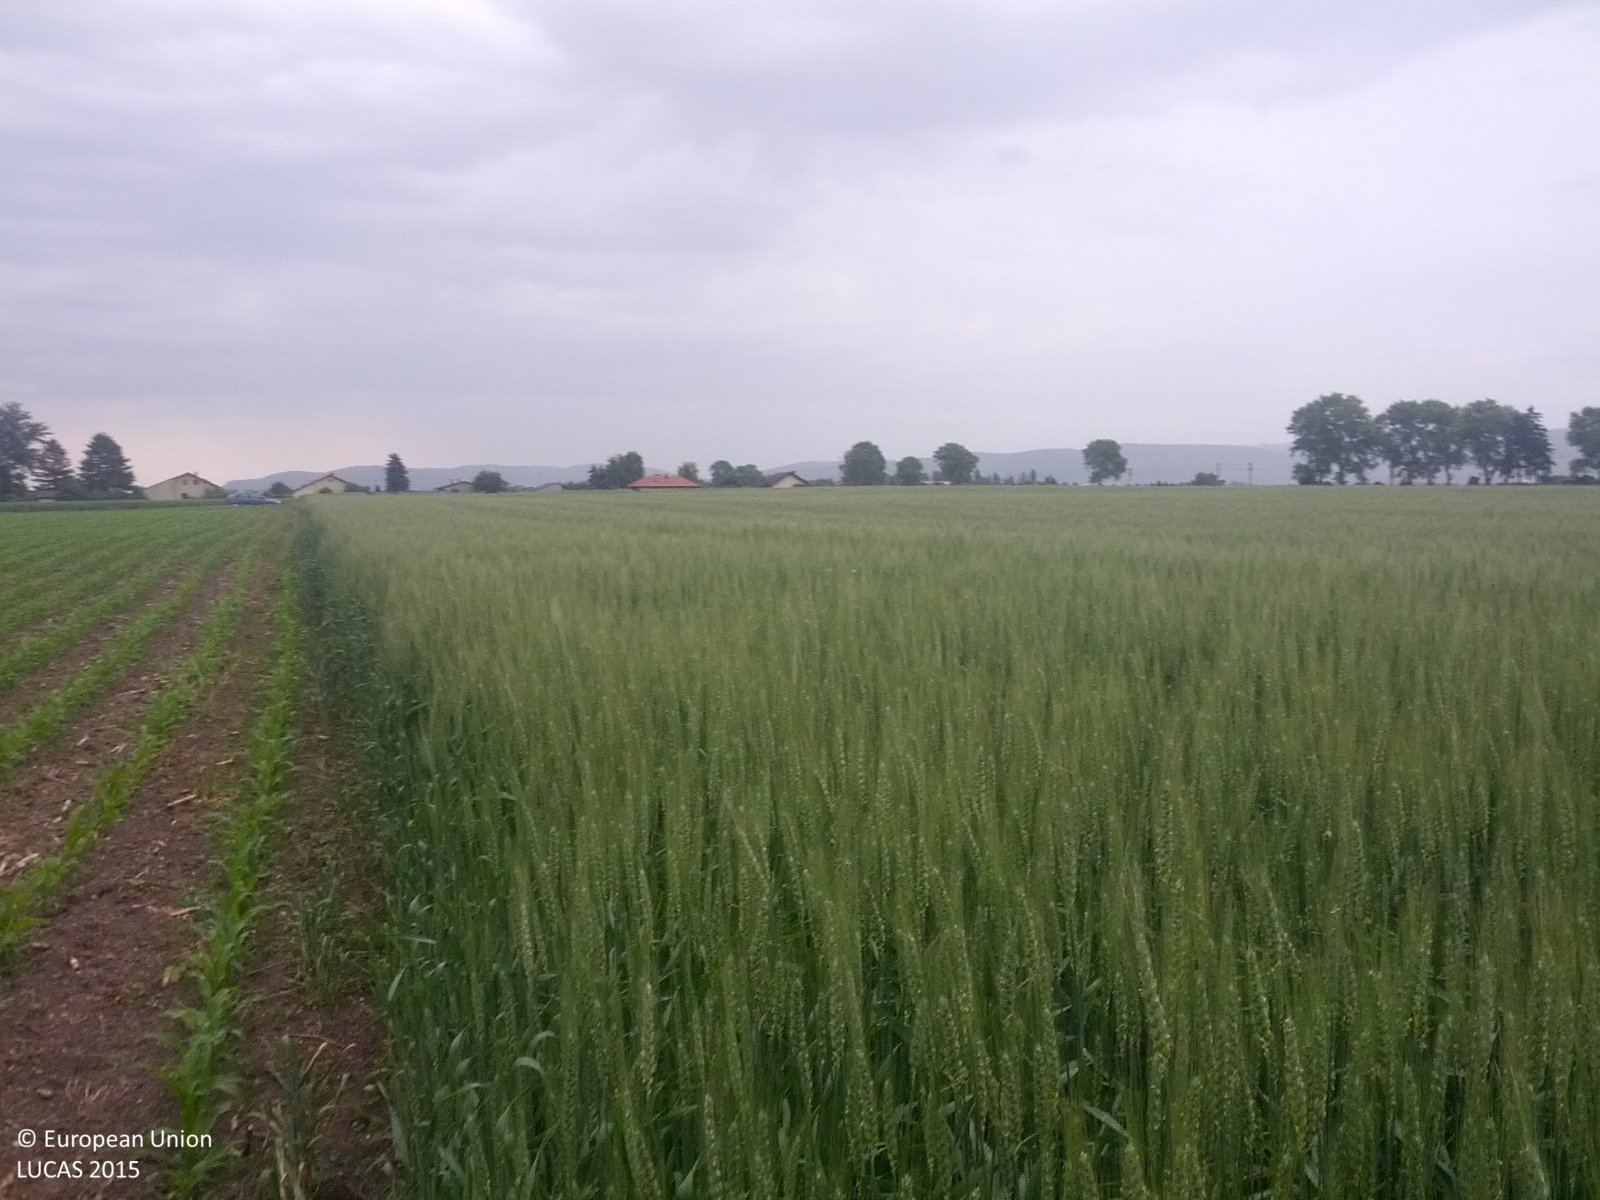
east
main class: Cropland
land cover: Durum wheat
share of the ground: > 75 %
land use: Agriculture (excluding fallow land and kitchen gardens)
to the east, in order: Durum wheat; Grass margins; Tracks; Grass margins; Common wheat; Other fresh vegetables; Barley
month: May
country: AT
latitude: 48.3260
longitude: 16.0872
